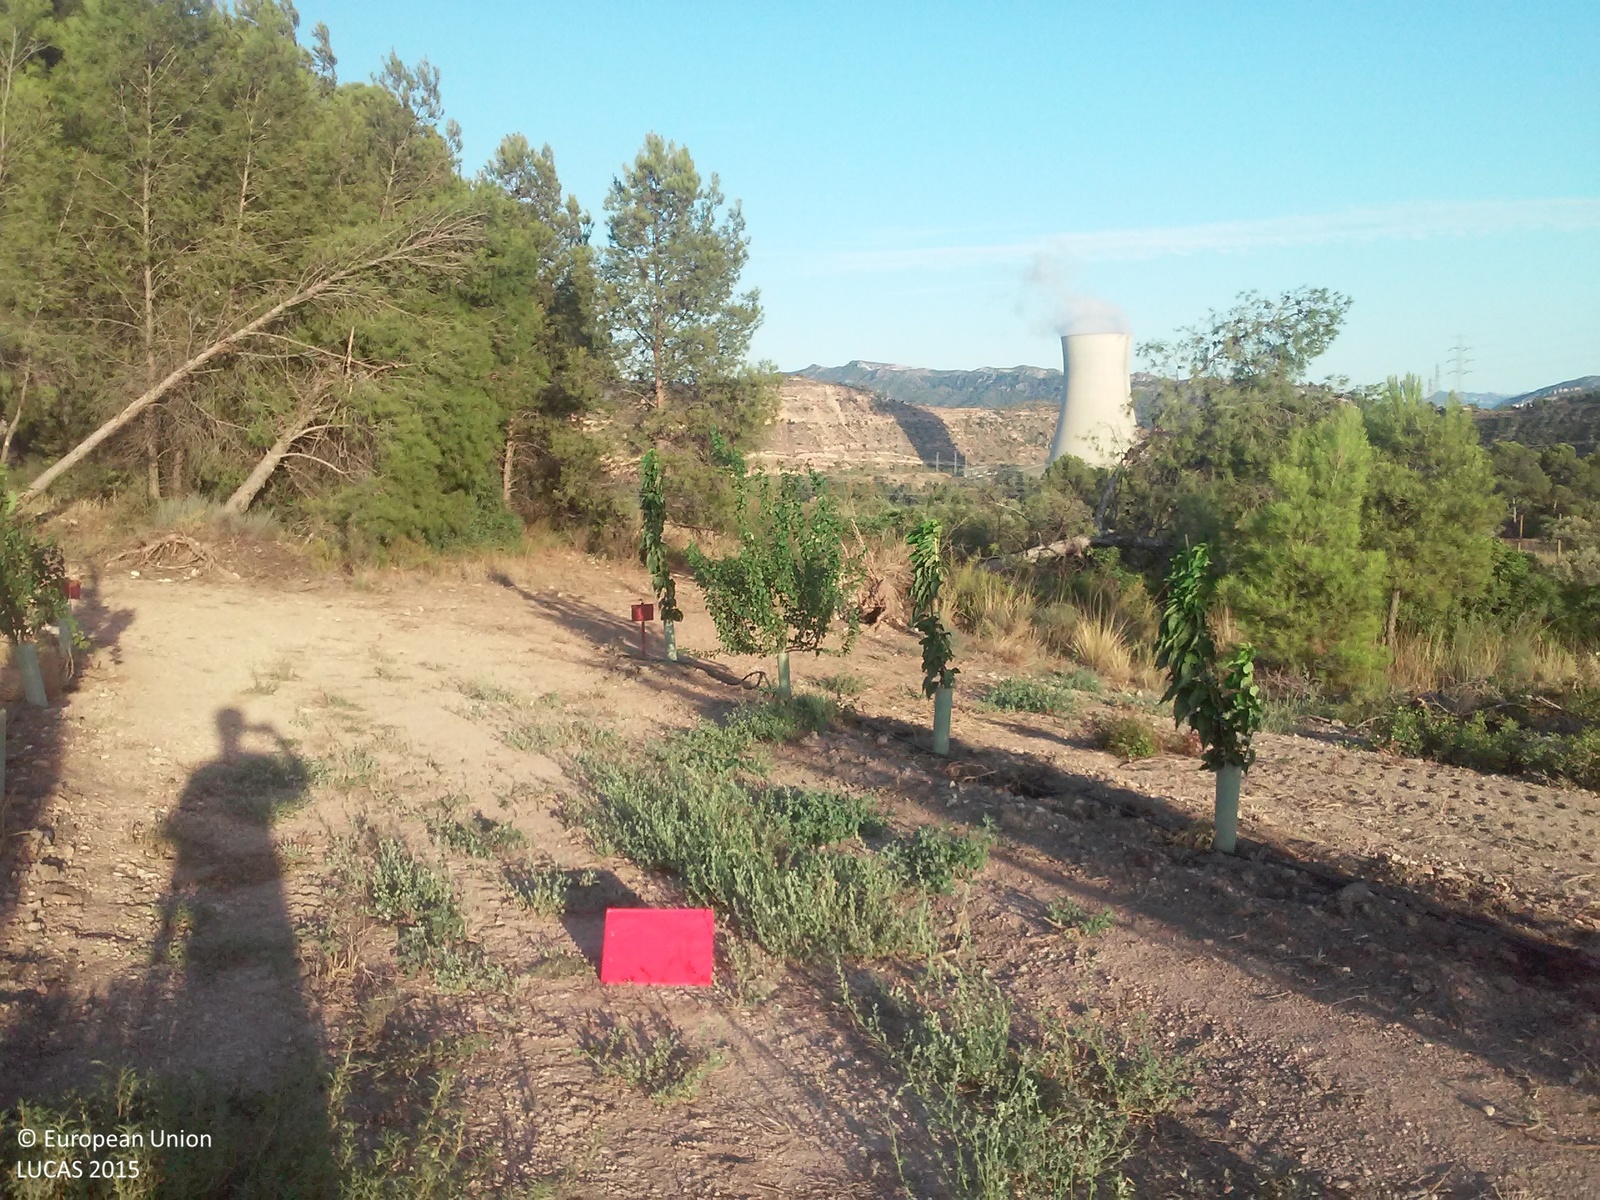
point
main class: Cropland
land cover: Other fruit trees and berries
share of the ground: < 10 %
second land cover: Spontaneously vegetated surfaces
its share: > 75 %
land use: Agriculture (excluding fallow land and kitchen gardens)
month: August
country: ES
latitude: 41.2121
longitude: 0.5565
